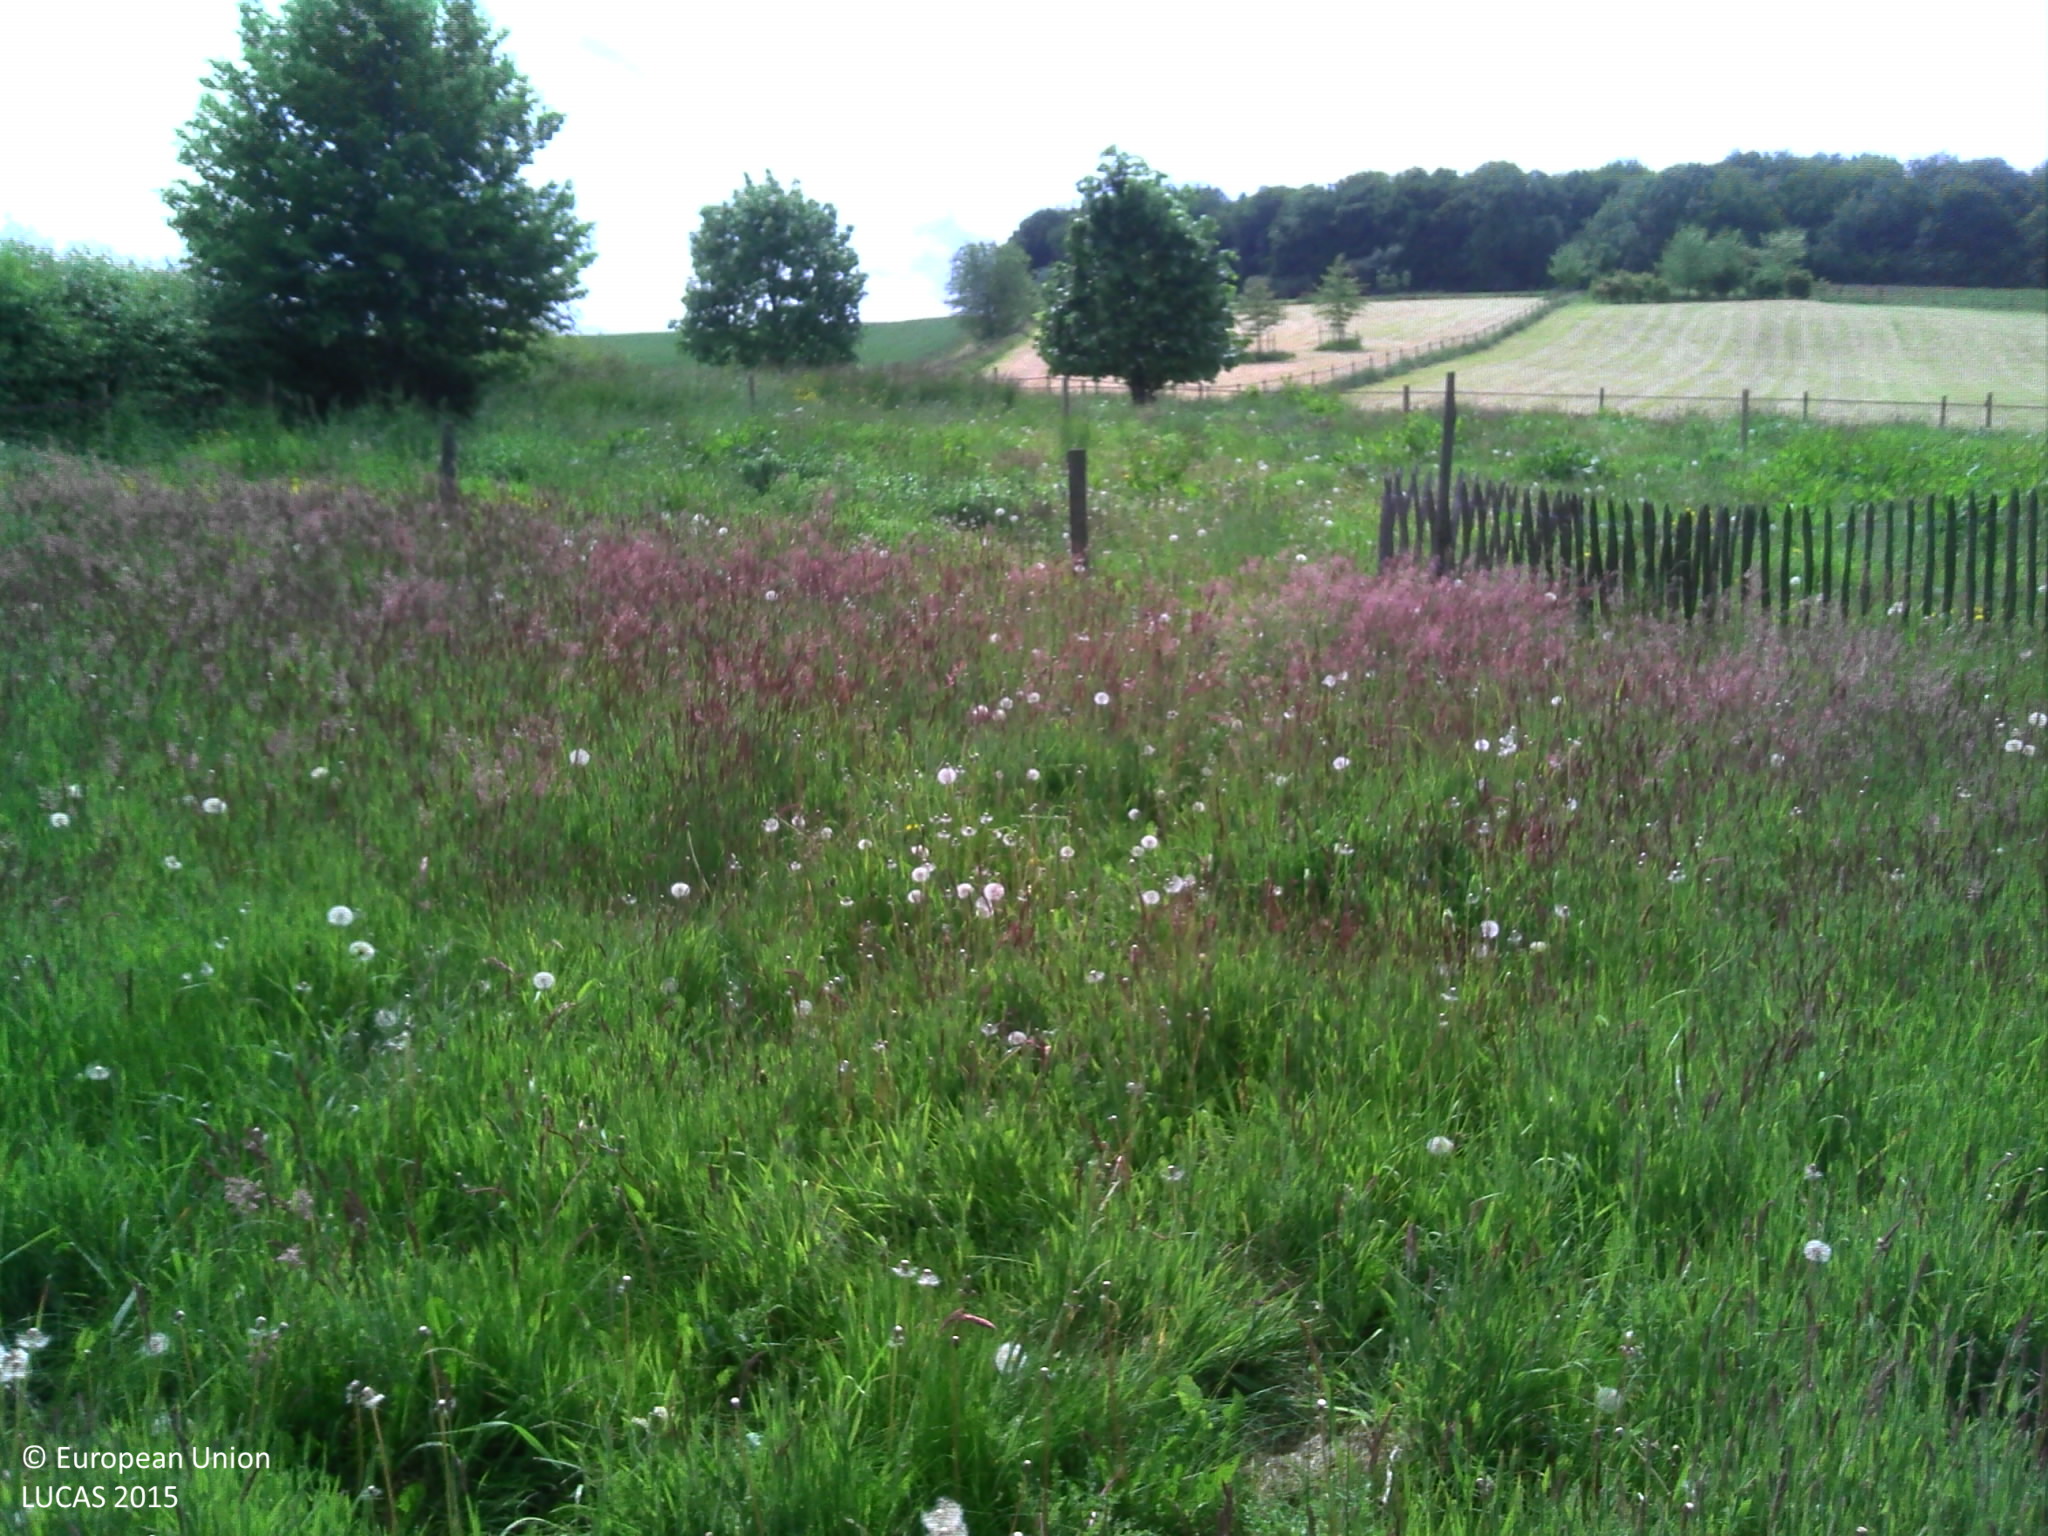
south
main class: Grassland
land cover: Grassland without tree/shrub cover
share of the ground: > 75 %
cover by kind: herbaceous plants 100 %
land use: Agriculture (excluding fallow land and kitchen gardens)
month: May
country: BE
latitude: 50.7589
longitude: 4.5949
